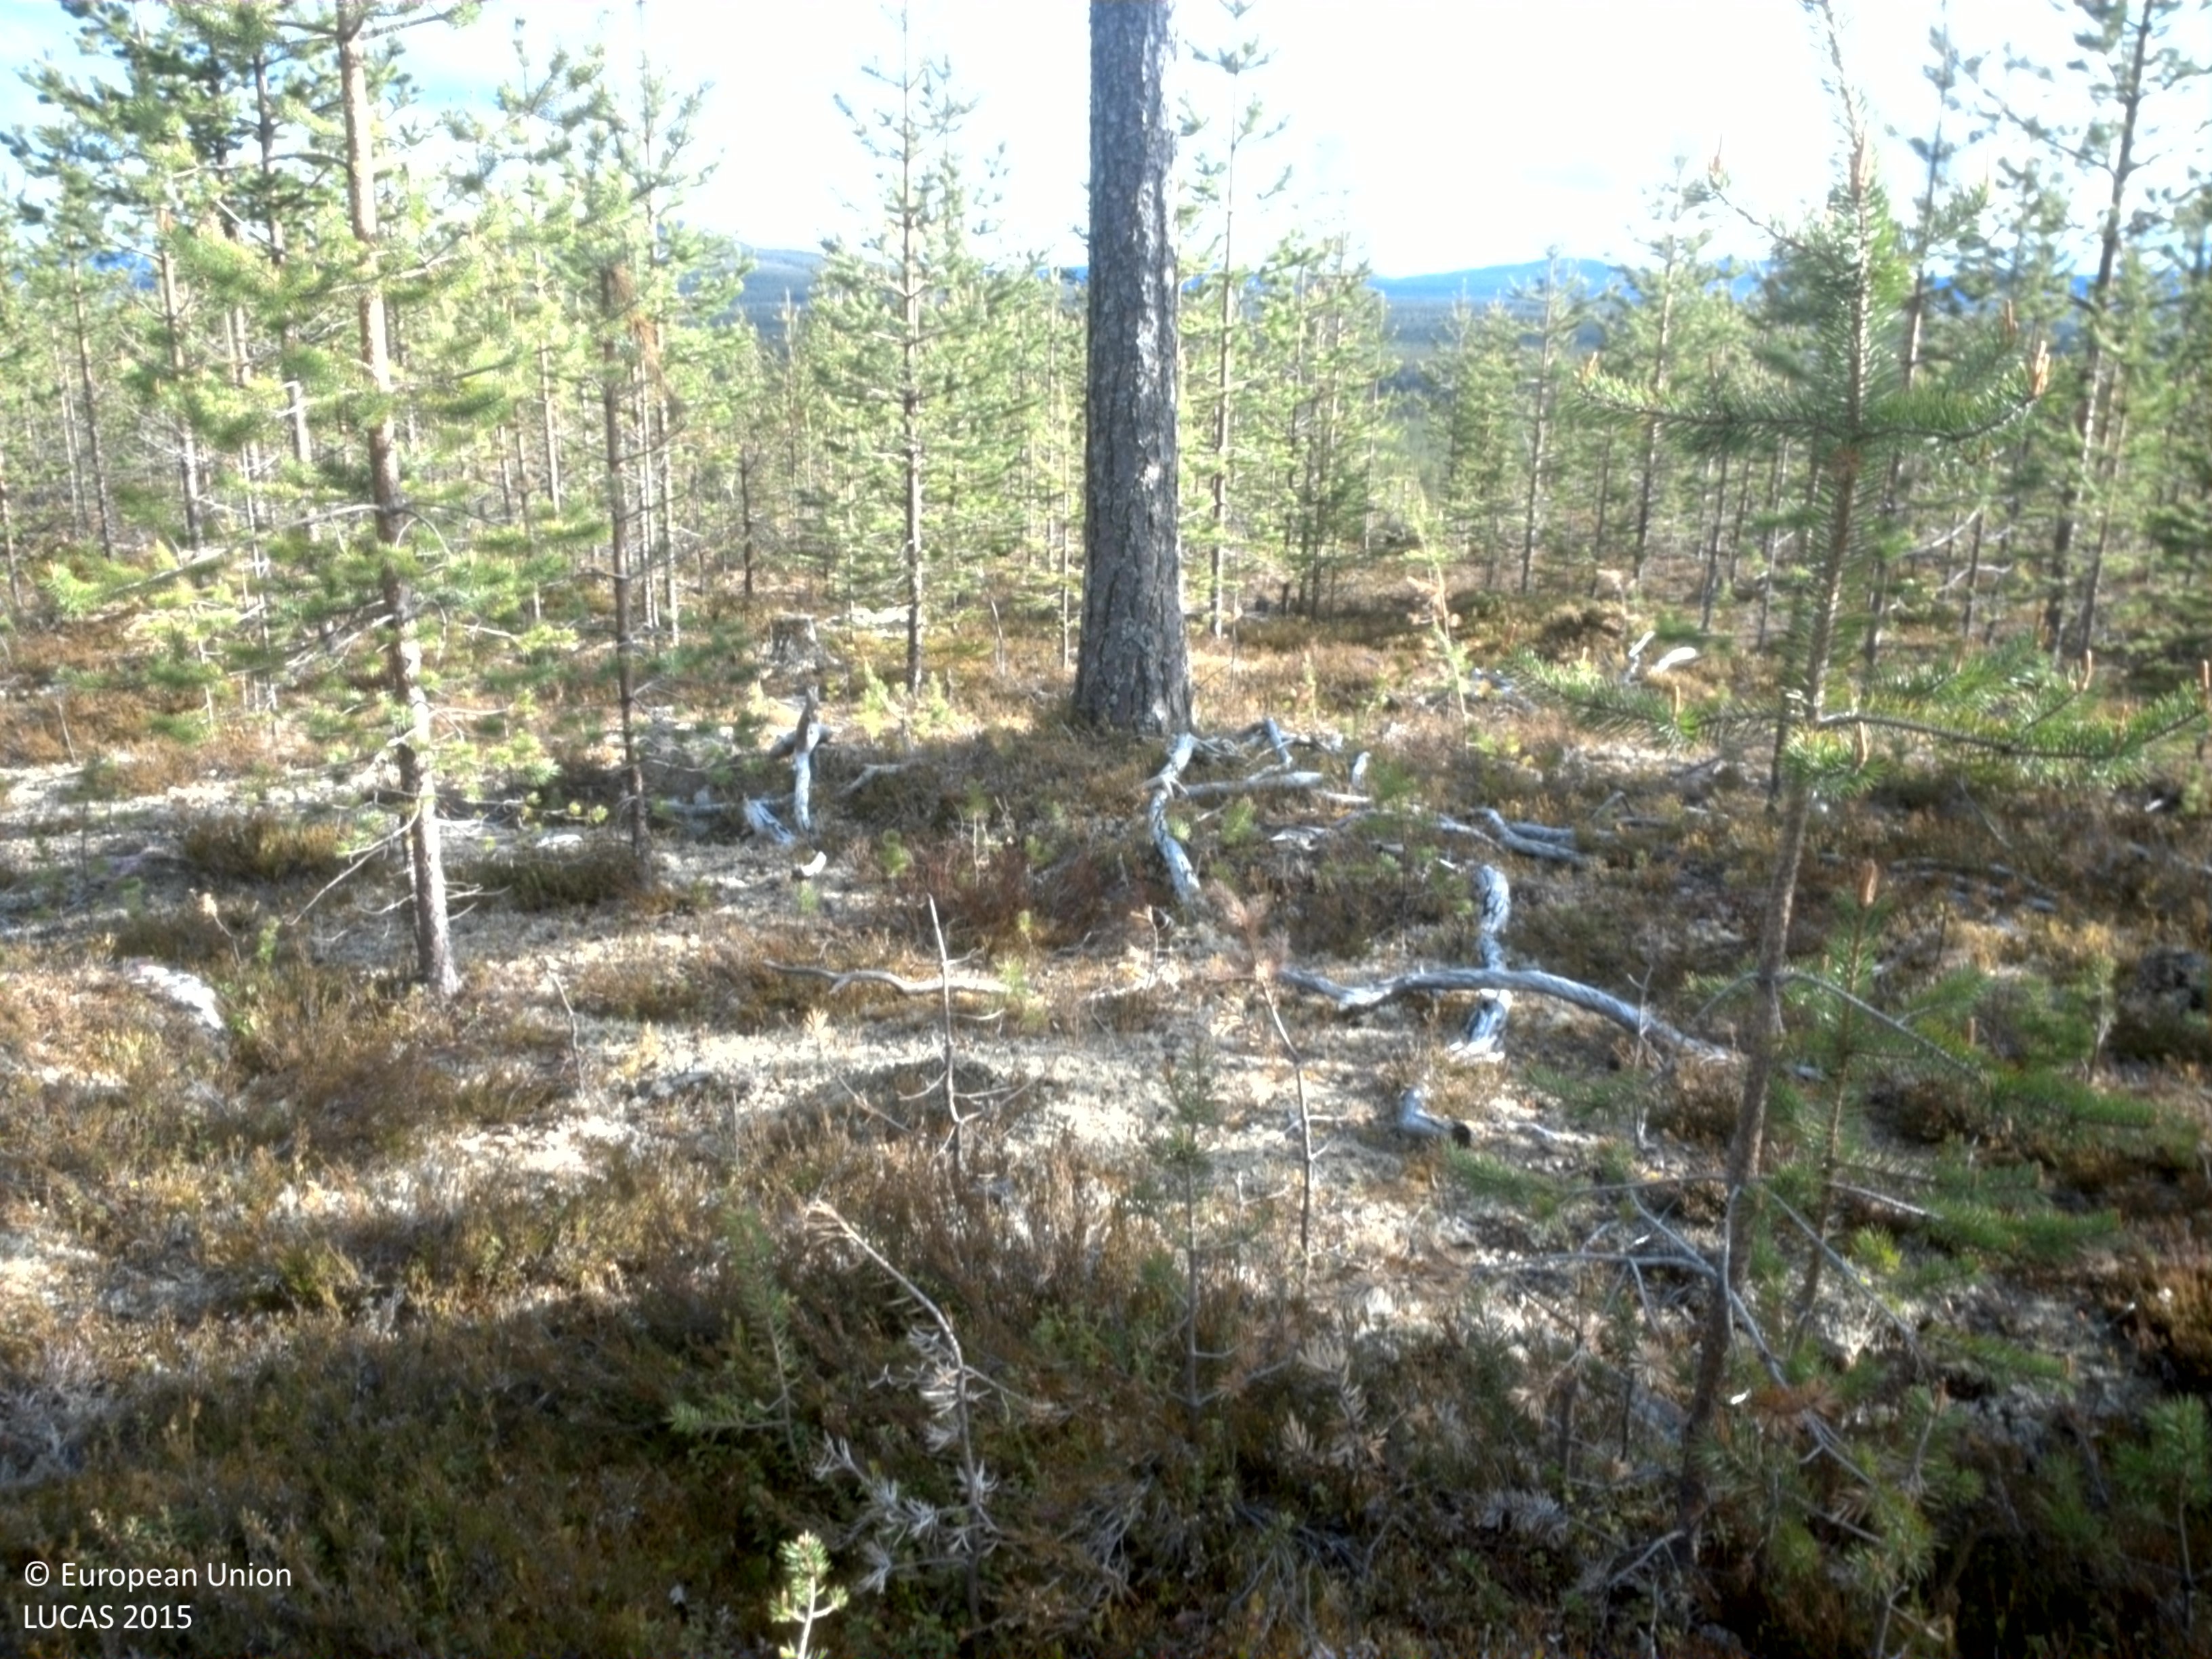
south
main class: Woodland
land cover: Pine dominated coniferous woodland
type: boreal forest
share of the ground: 25 - 50 %
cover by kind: shrubs 45 %, coniferous forest trees 40 %, lichens and mosses 15 %
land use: Forestry
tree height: > 5 m
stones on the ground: 10 - 25 %
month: June
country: SE
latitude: 66.9114
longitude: 22.0041
